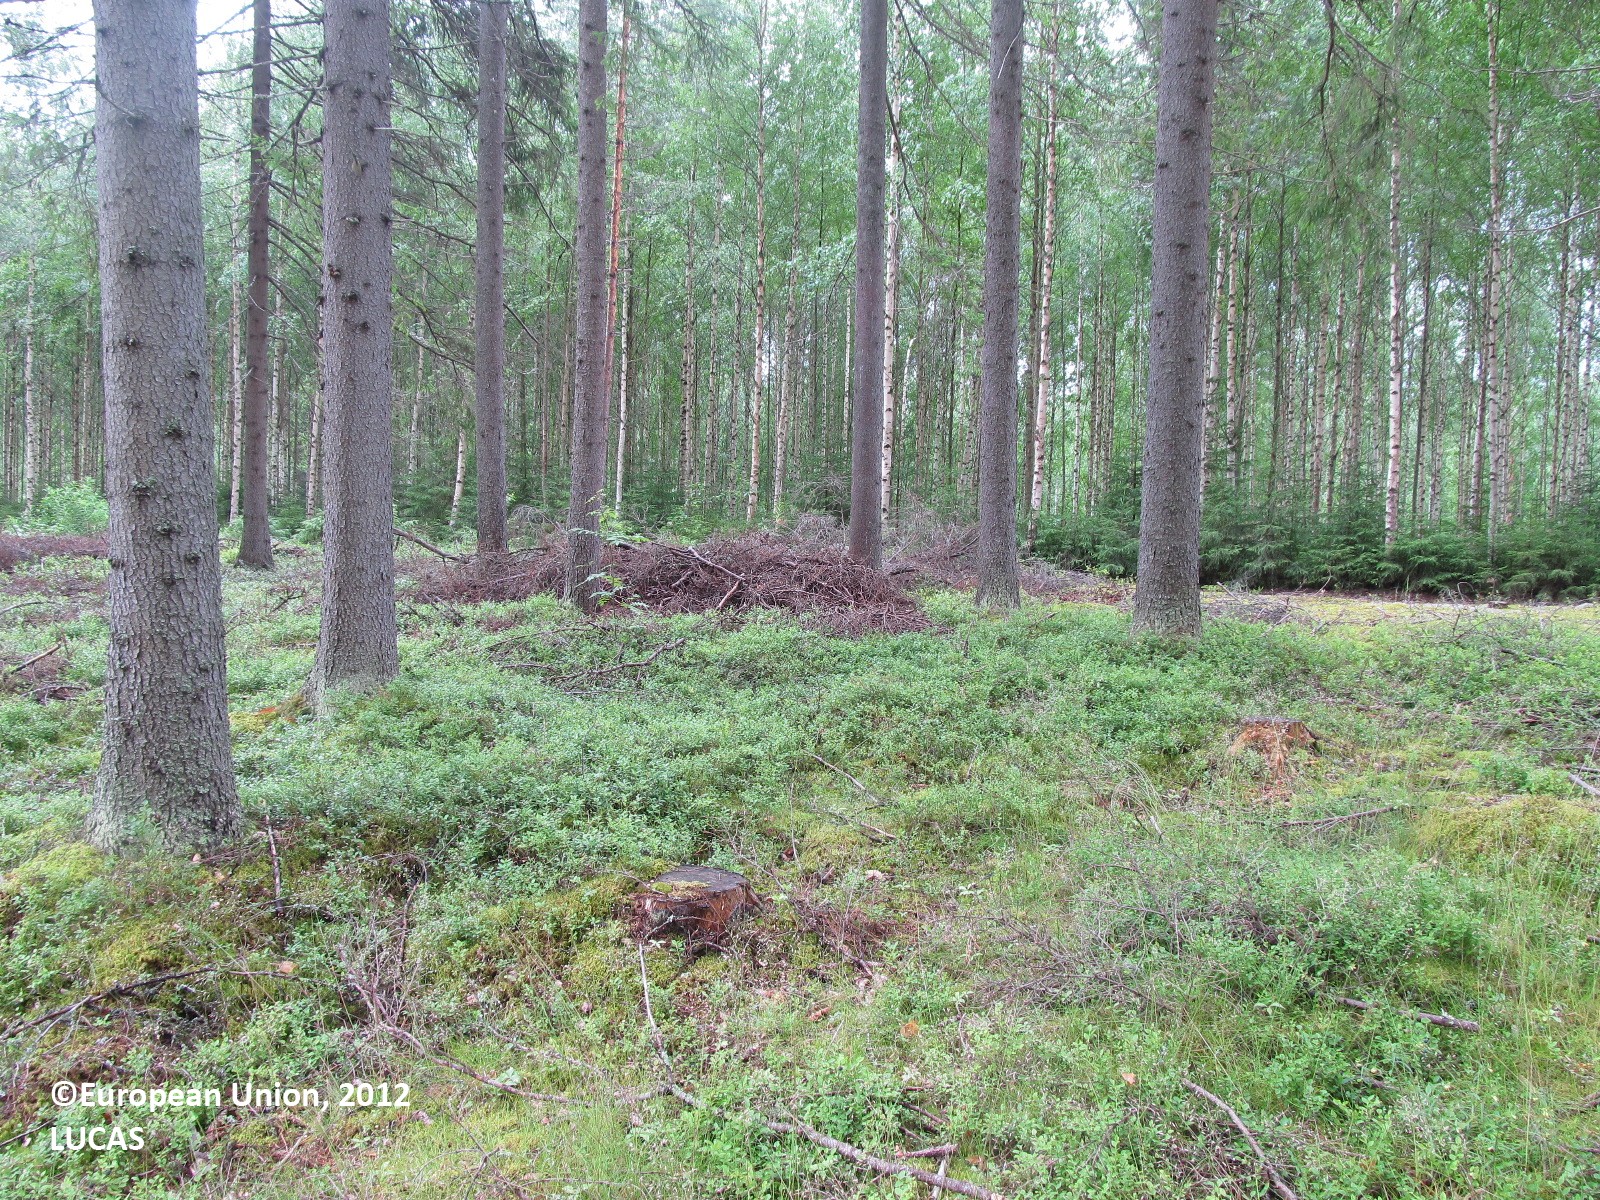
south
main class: Woodland
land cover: Spruce dominated coniferous woodland
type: boreal forest
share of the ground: 25 - 50 %
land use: Forestry
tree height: > 5 m
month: July
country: FI
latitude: 61.8884
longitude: 28.4109
